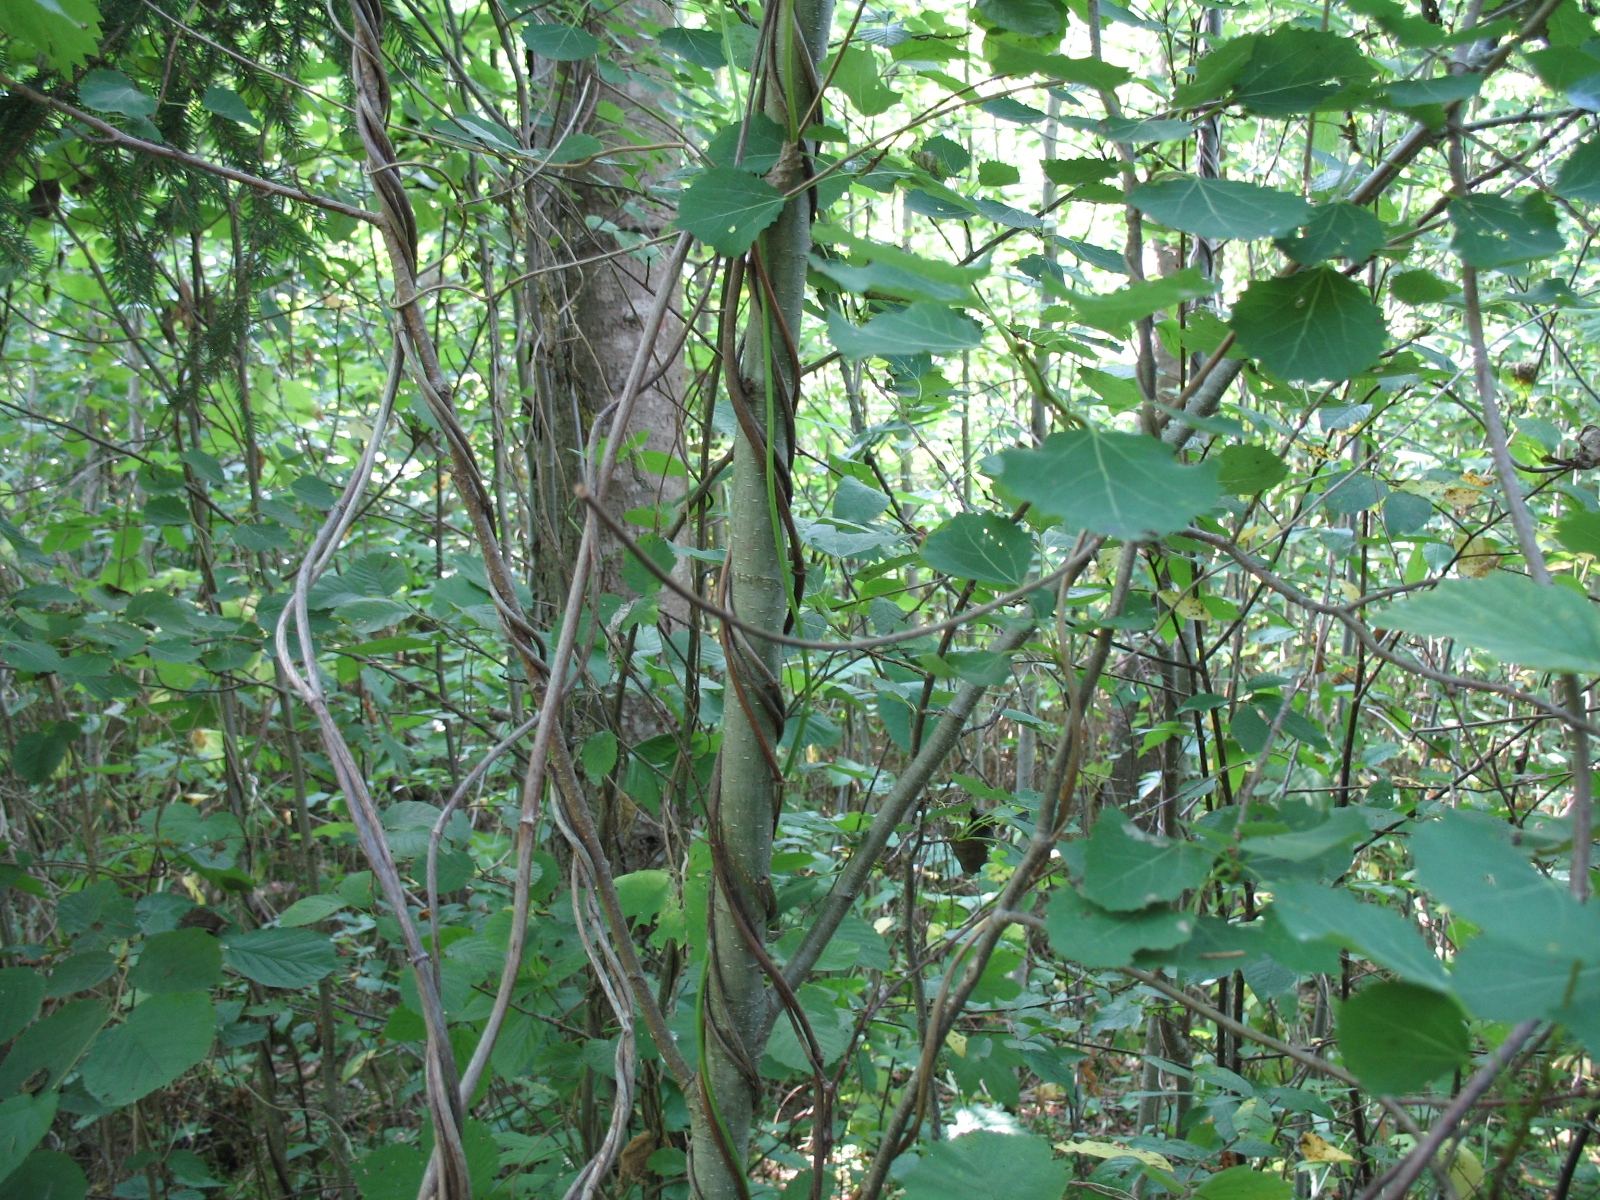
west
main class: Woodland
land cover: Spruce dominated mixed woodland
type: hemiboreal forest and nemoral coniferous forest and mixed broadleaved-coniferous forest
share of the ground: > 75 %
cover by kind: broadleaved forest trees 65 %, coniferous forest trees 30 %, herbaceous plants 5 %
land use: Forestry
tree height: > 5 m
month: August
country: LV
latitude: 56.2020
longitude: 25.4163
